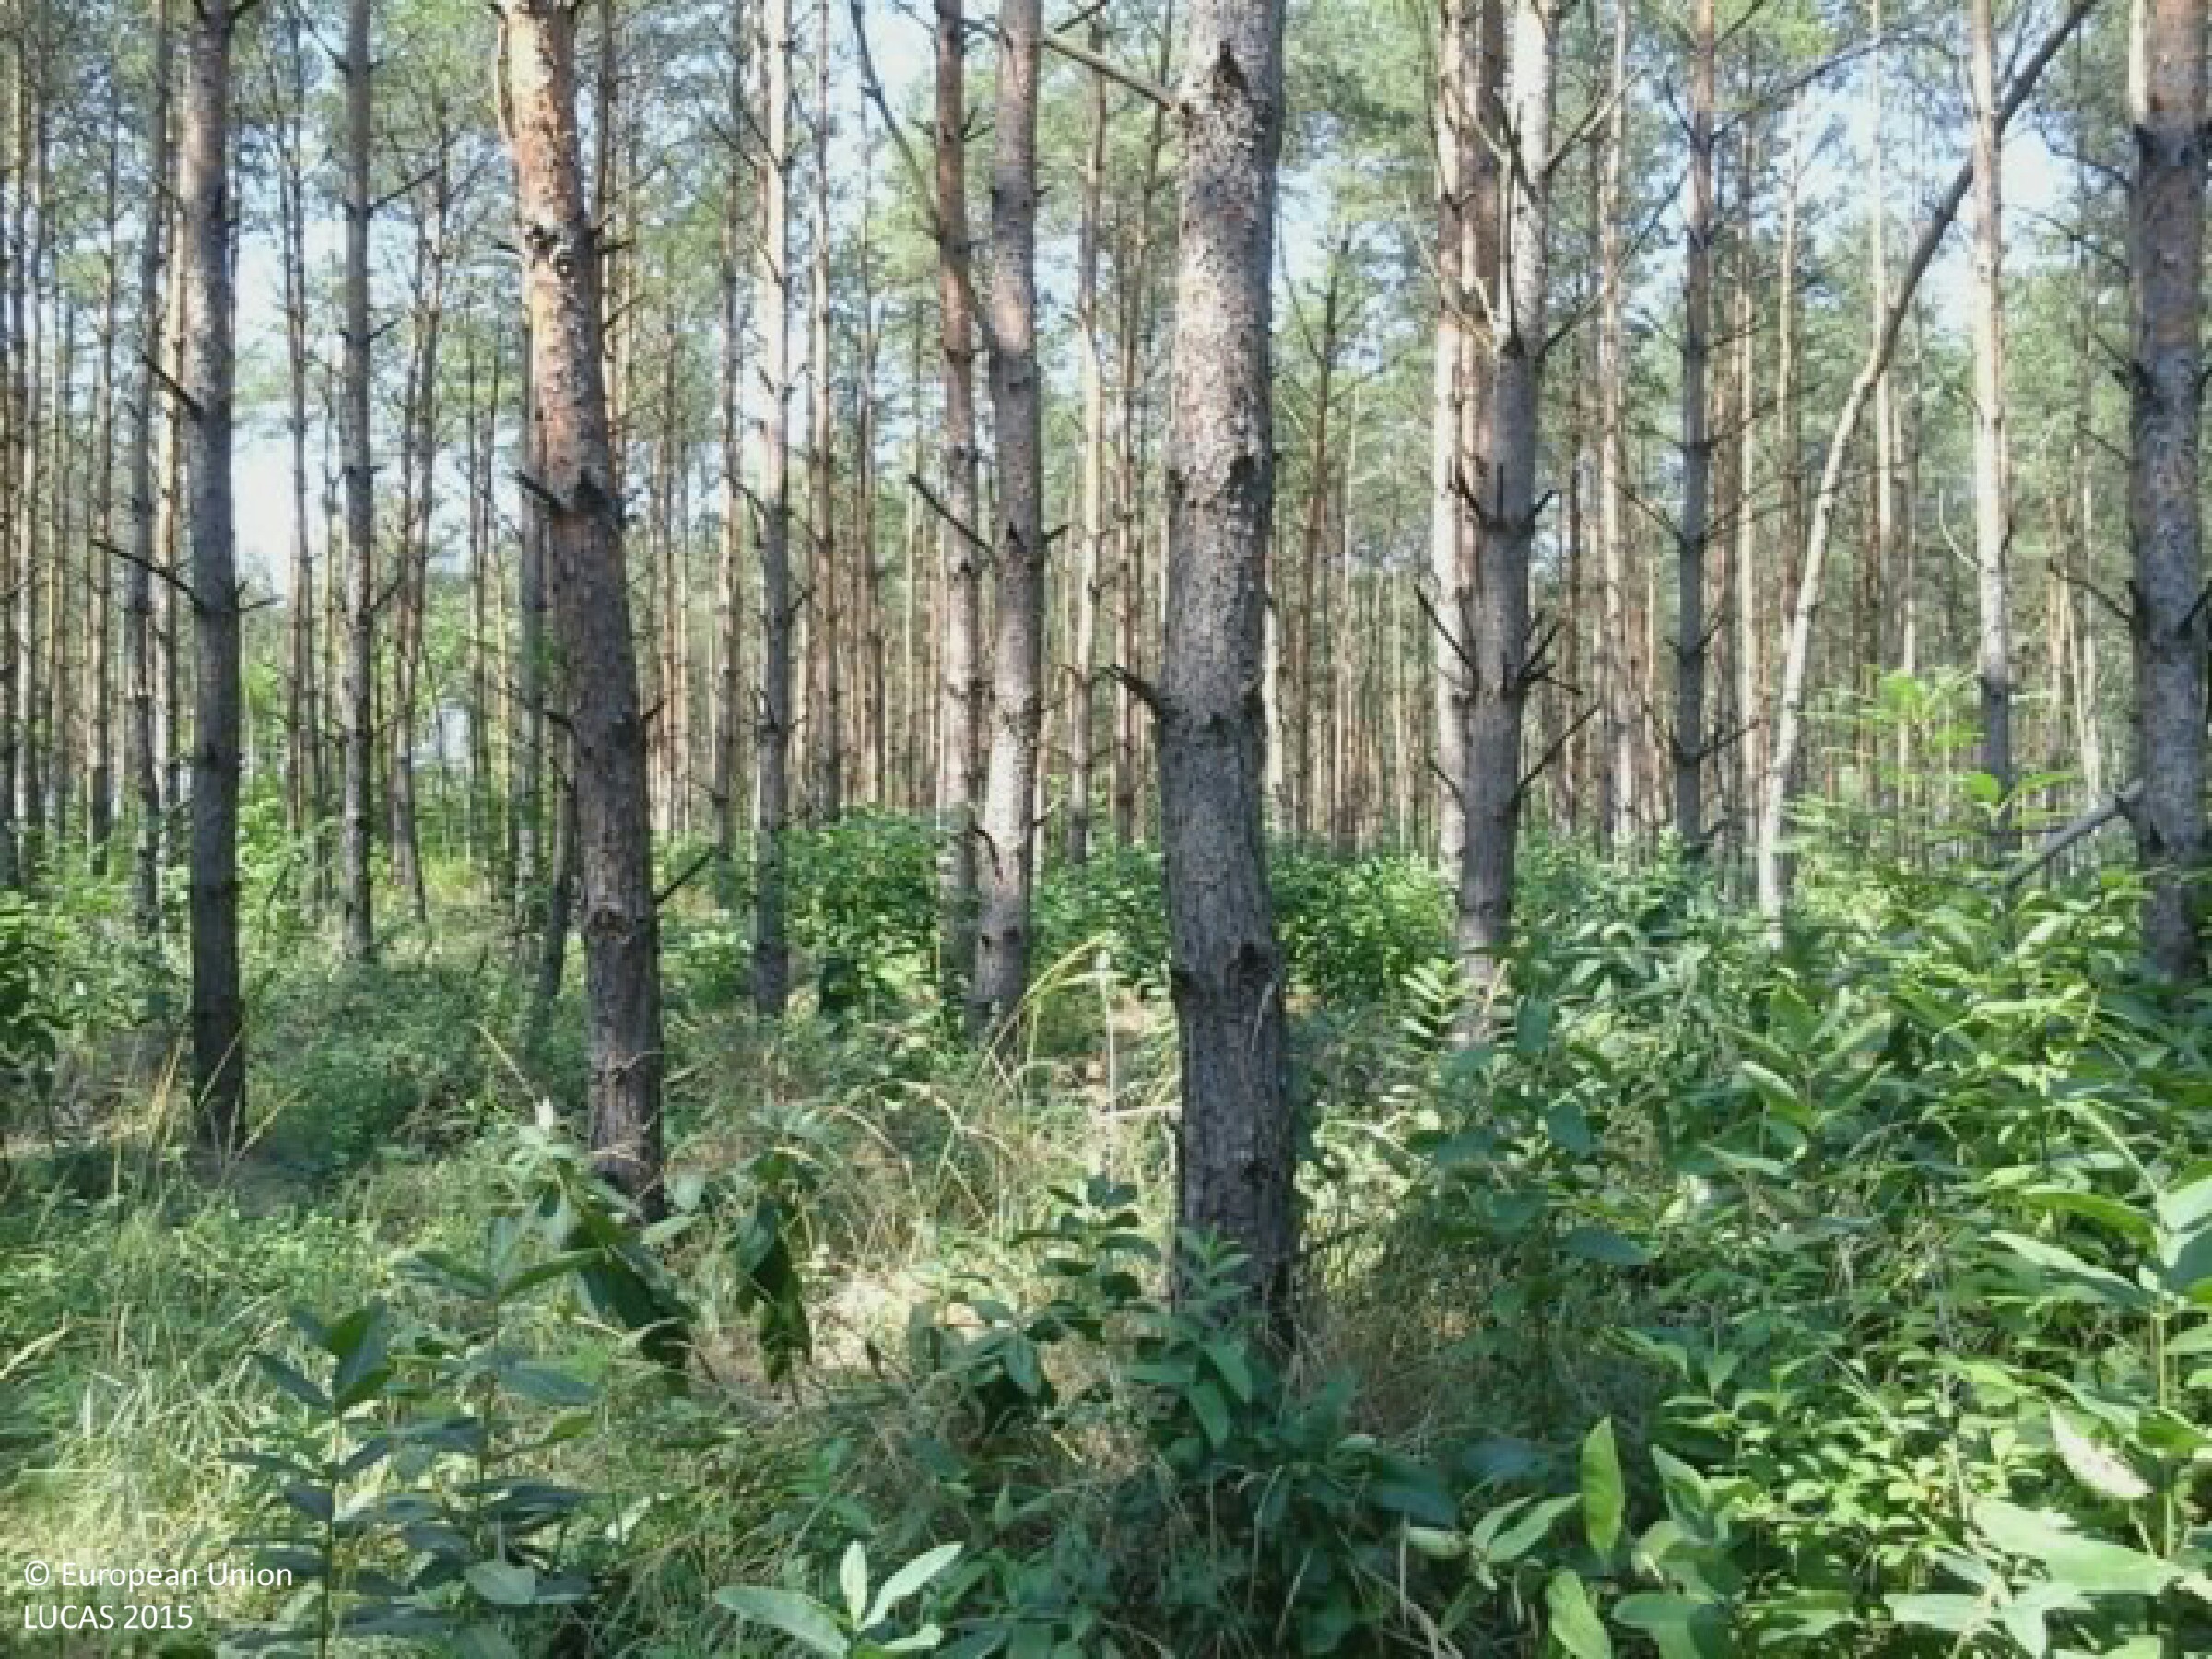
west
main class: Woodland
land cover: Pine dominated coniferous woodland
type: alpine coniferous forest
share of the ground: > 75 %
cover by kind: coniferous forest trees 75 %, herbaceous plants 15 %, shrubs 10 %
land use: Forestry
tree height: > 5 m
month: August
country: HU
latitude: 47.3162
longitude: 19.3727
